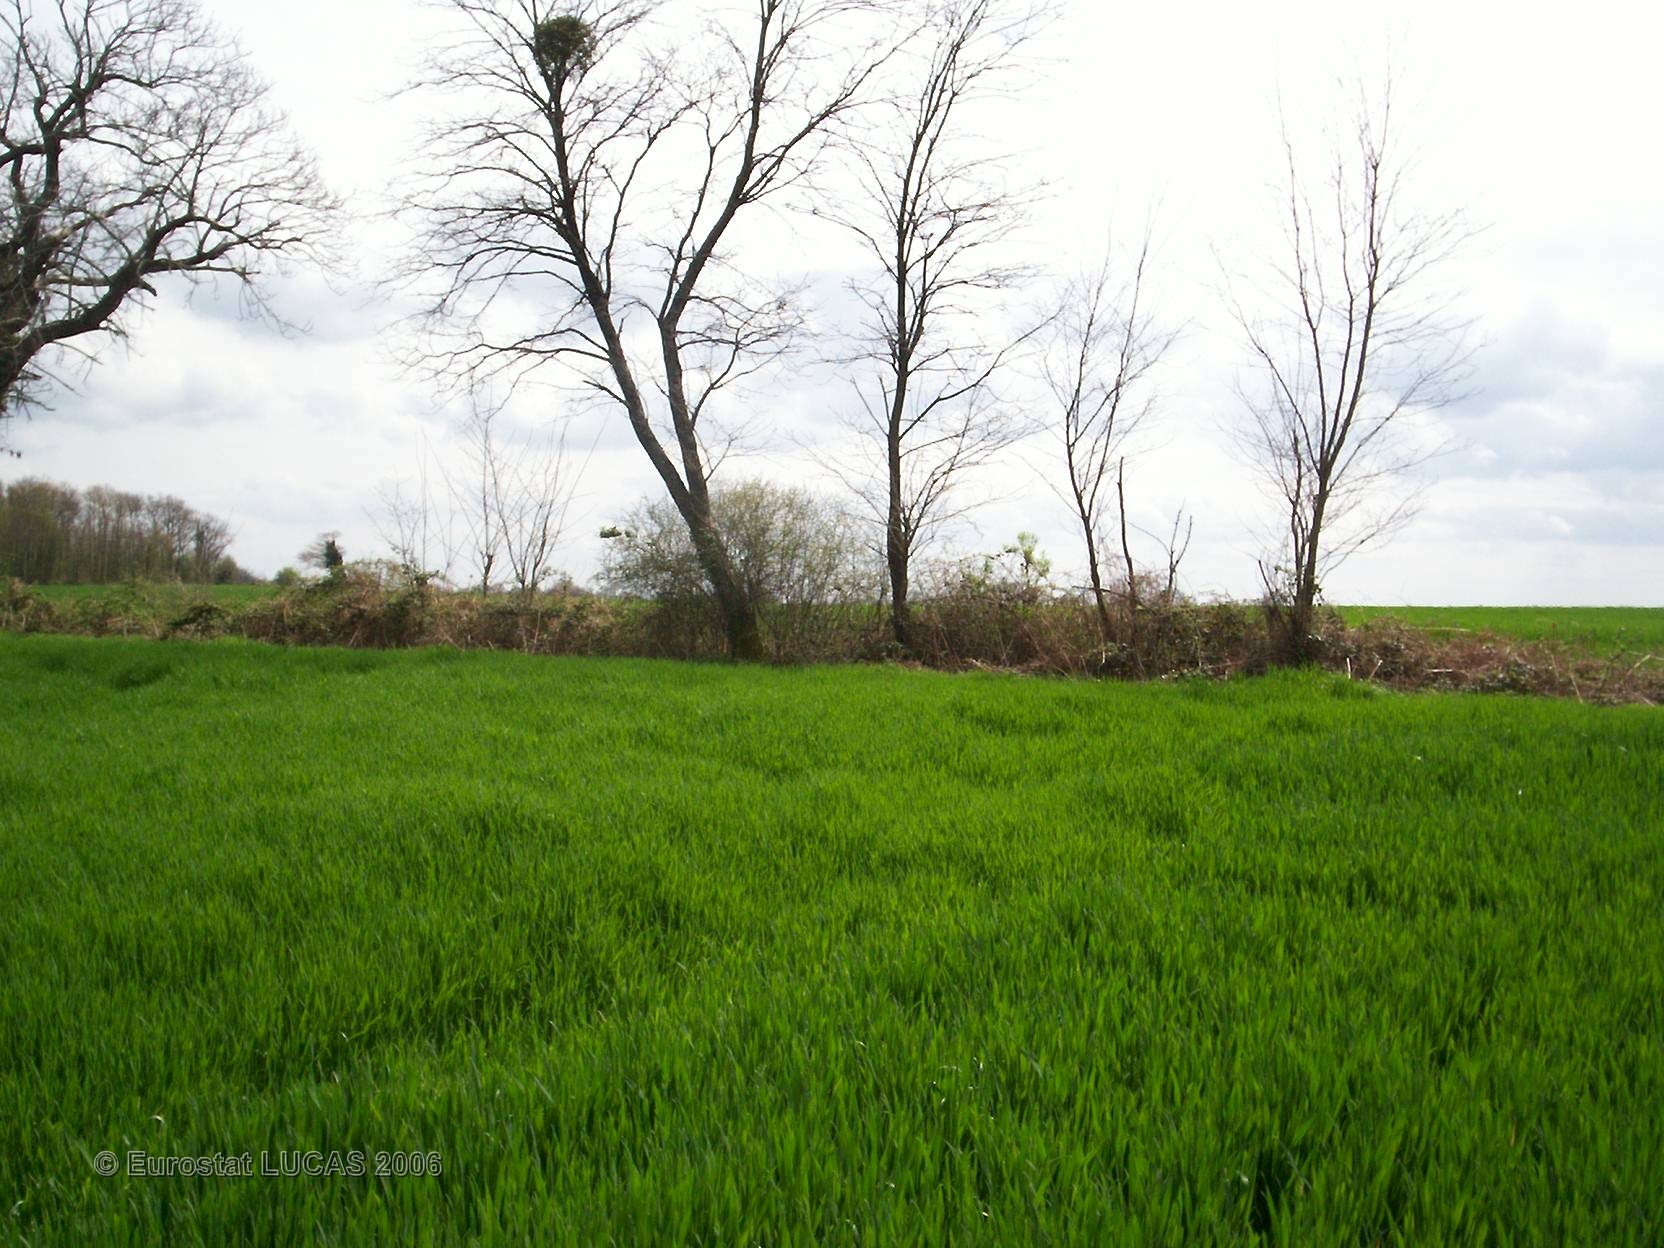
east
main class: Cropland
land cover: Common wheat
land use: Agriculture (excluding fallow land and kitchen gardens)
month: April
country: FR
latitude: 46.1066
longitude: 0.4751
